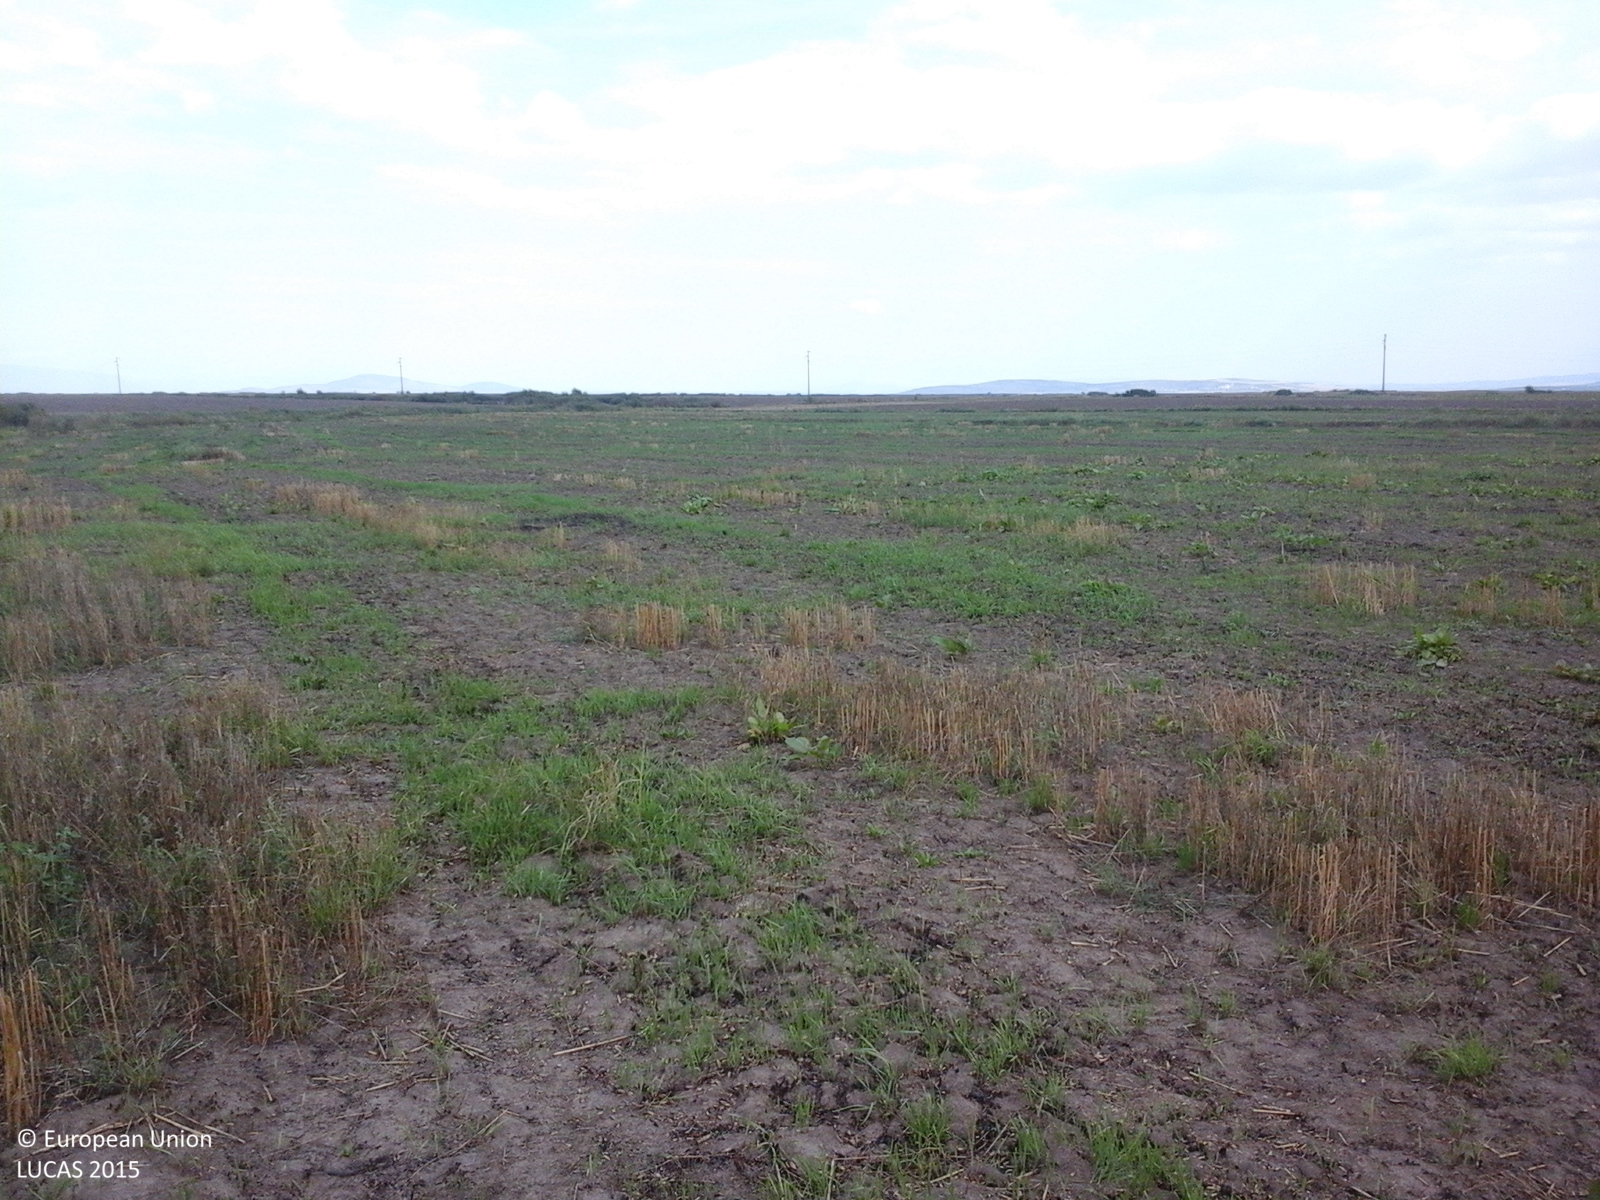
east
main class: Cropland
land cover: Durum wheat
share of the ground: 10 - 25 %
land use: Agriculture (excluding fallow land and kitchen gardens)
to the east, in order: Durum wheat
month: August
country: RO
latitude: 46.3758
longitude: 21.5696
